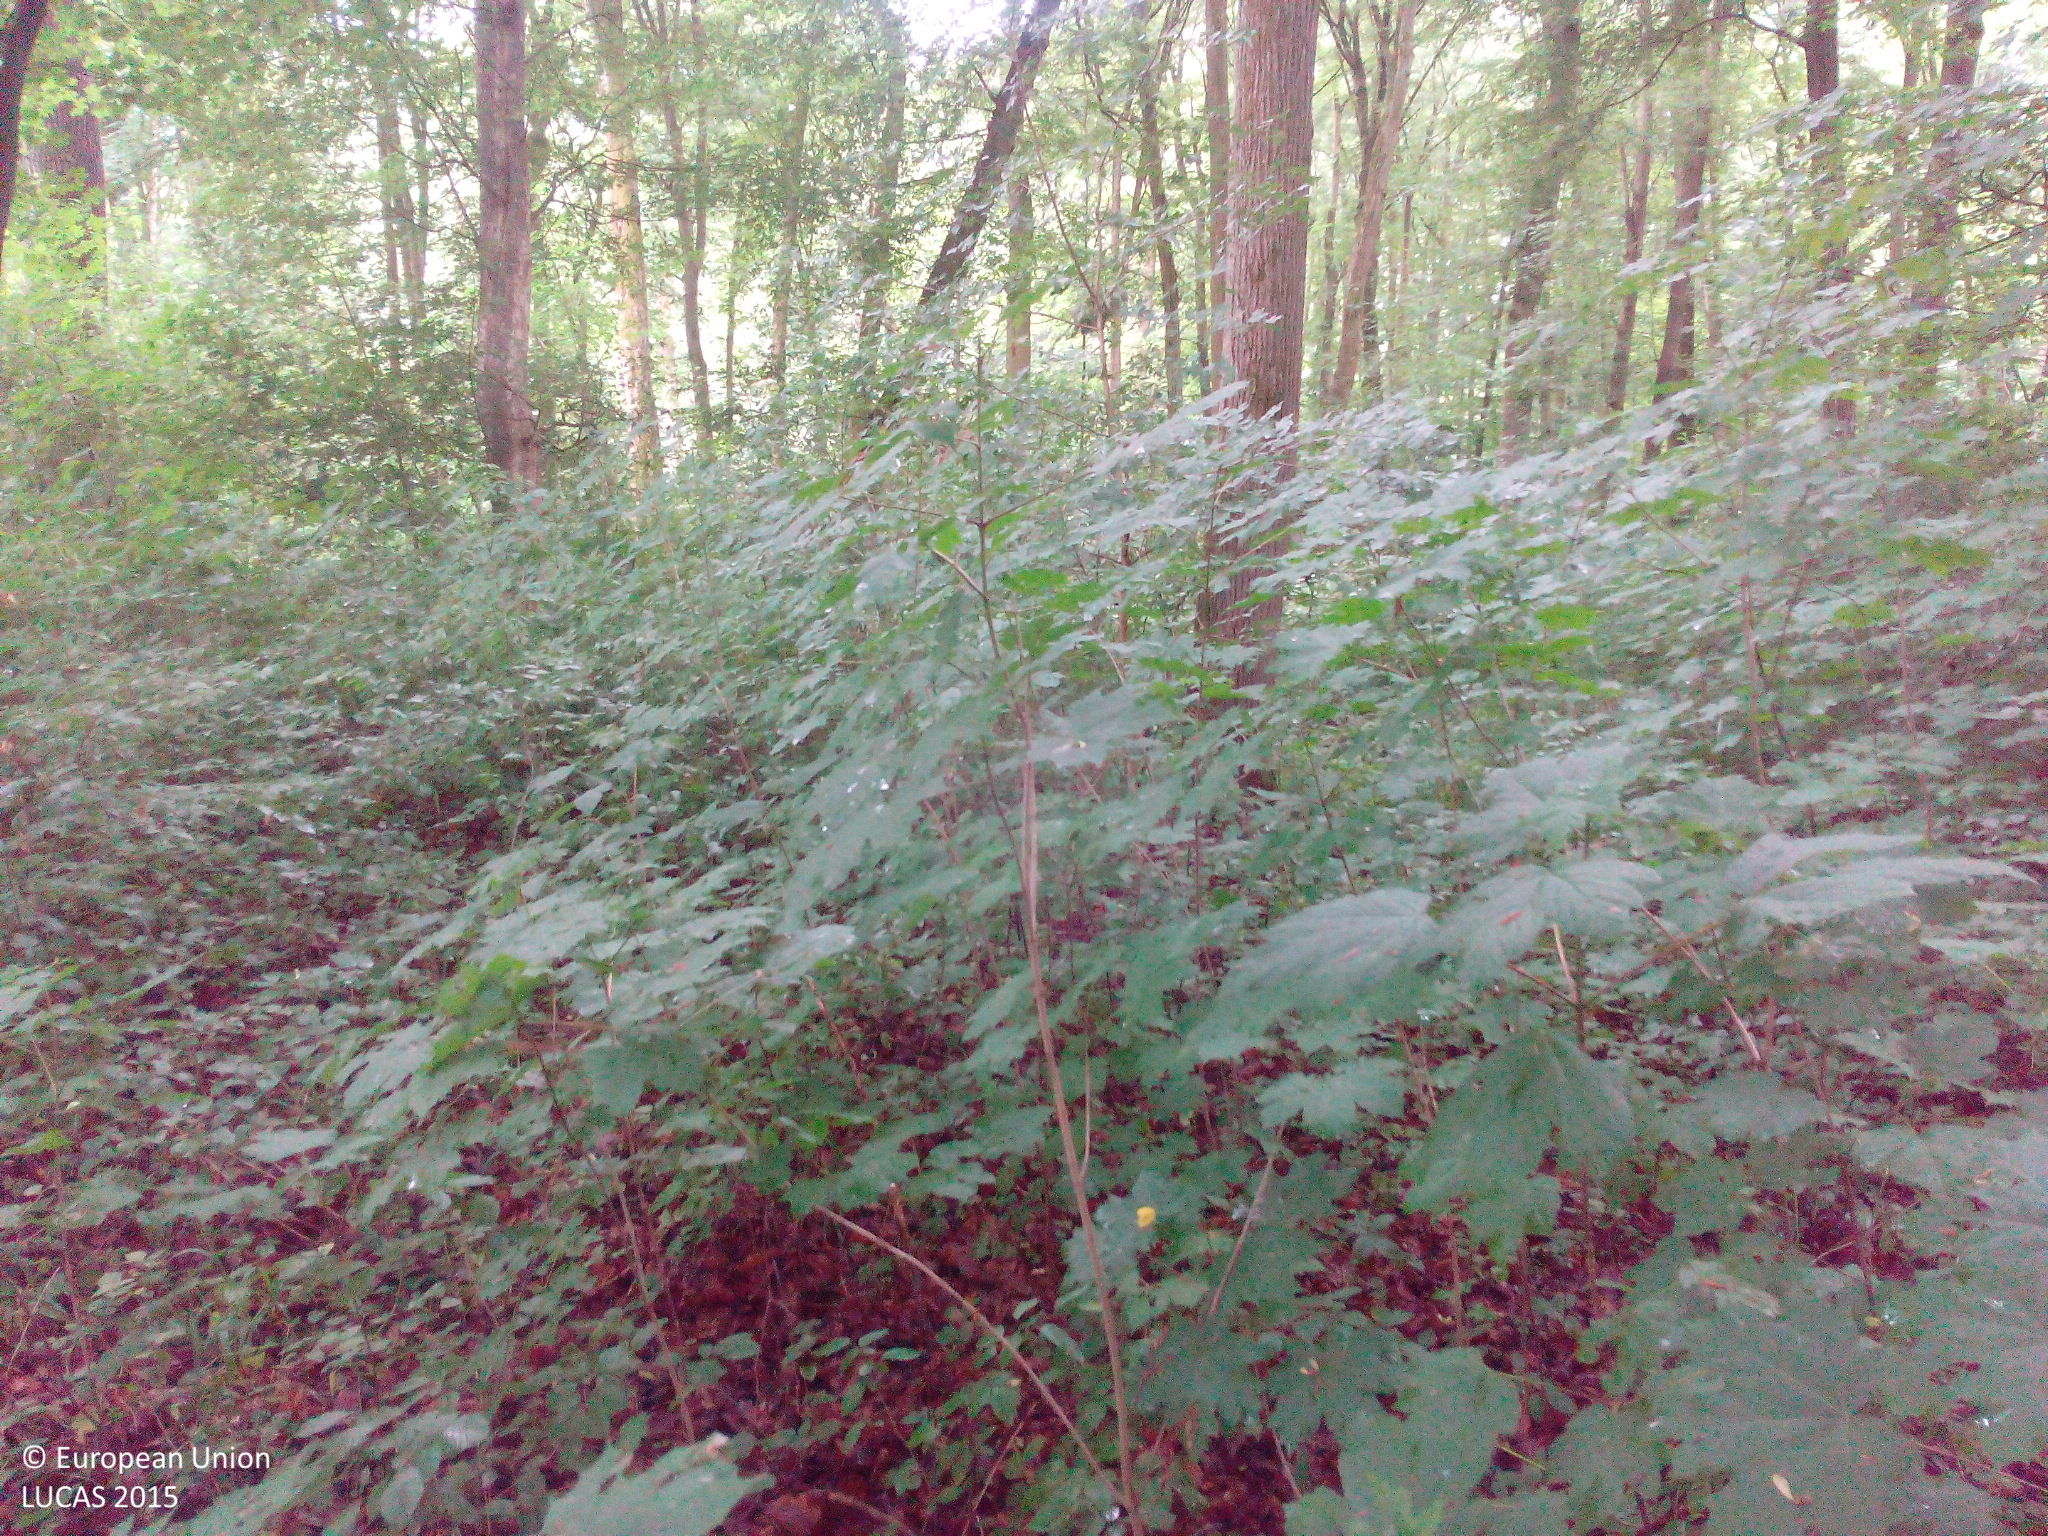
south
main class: Woodland
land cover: Broadleaved woodland
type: mesophytic deciduous forest
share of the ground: > 75 %
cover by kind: broadleaved forest trees 100 %
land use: Amenities, museums, leisure
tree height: > 5 m
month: June
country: DE
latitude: 49.8749
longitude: 10.9042
